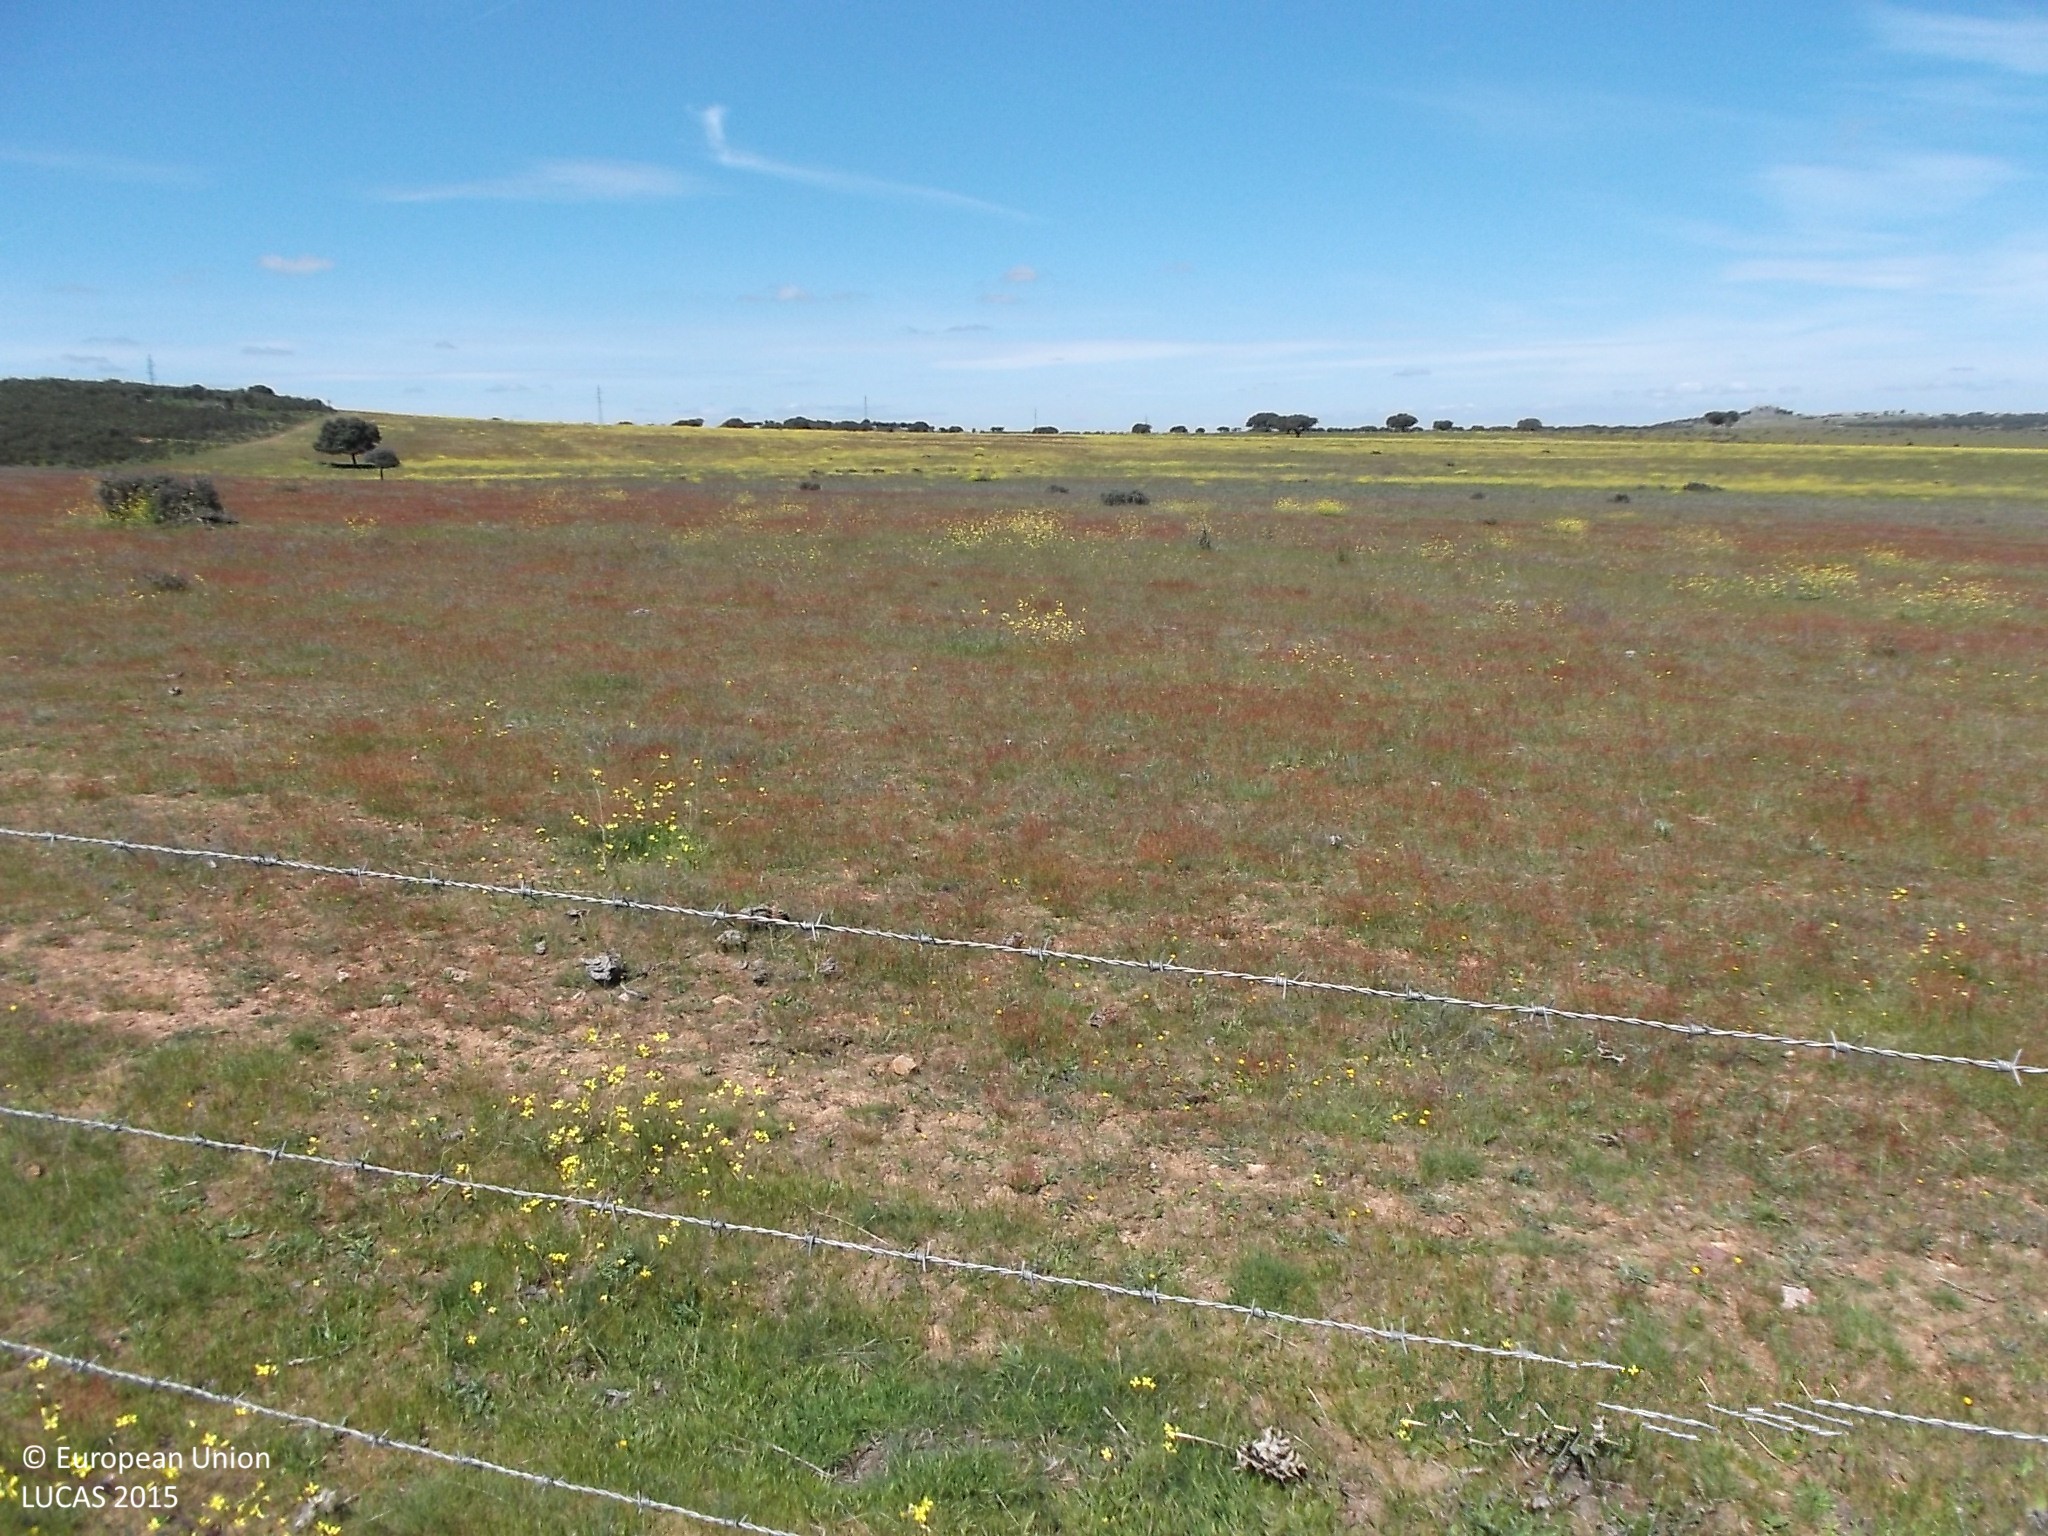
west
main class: Grassland
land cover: Grassland without tree/shrub cover
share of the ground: > 75 %
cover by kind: herbaceous plants 100 %
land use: Agriculture (excluding fallow land and kitchen gardens)
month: April
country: ES
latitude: 41.0370
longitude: -5.9157
